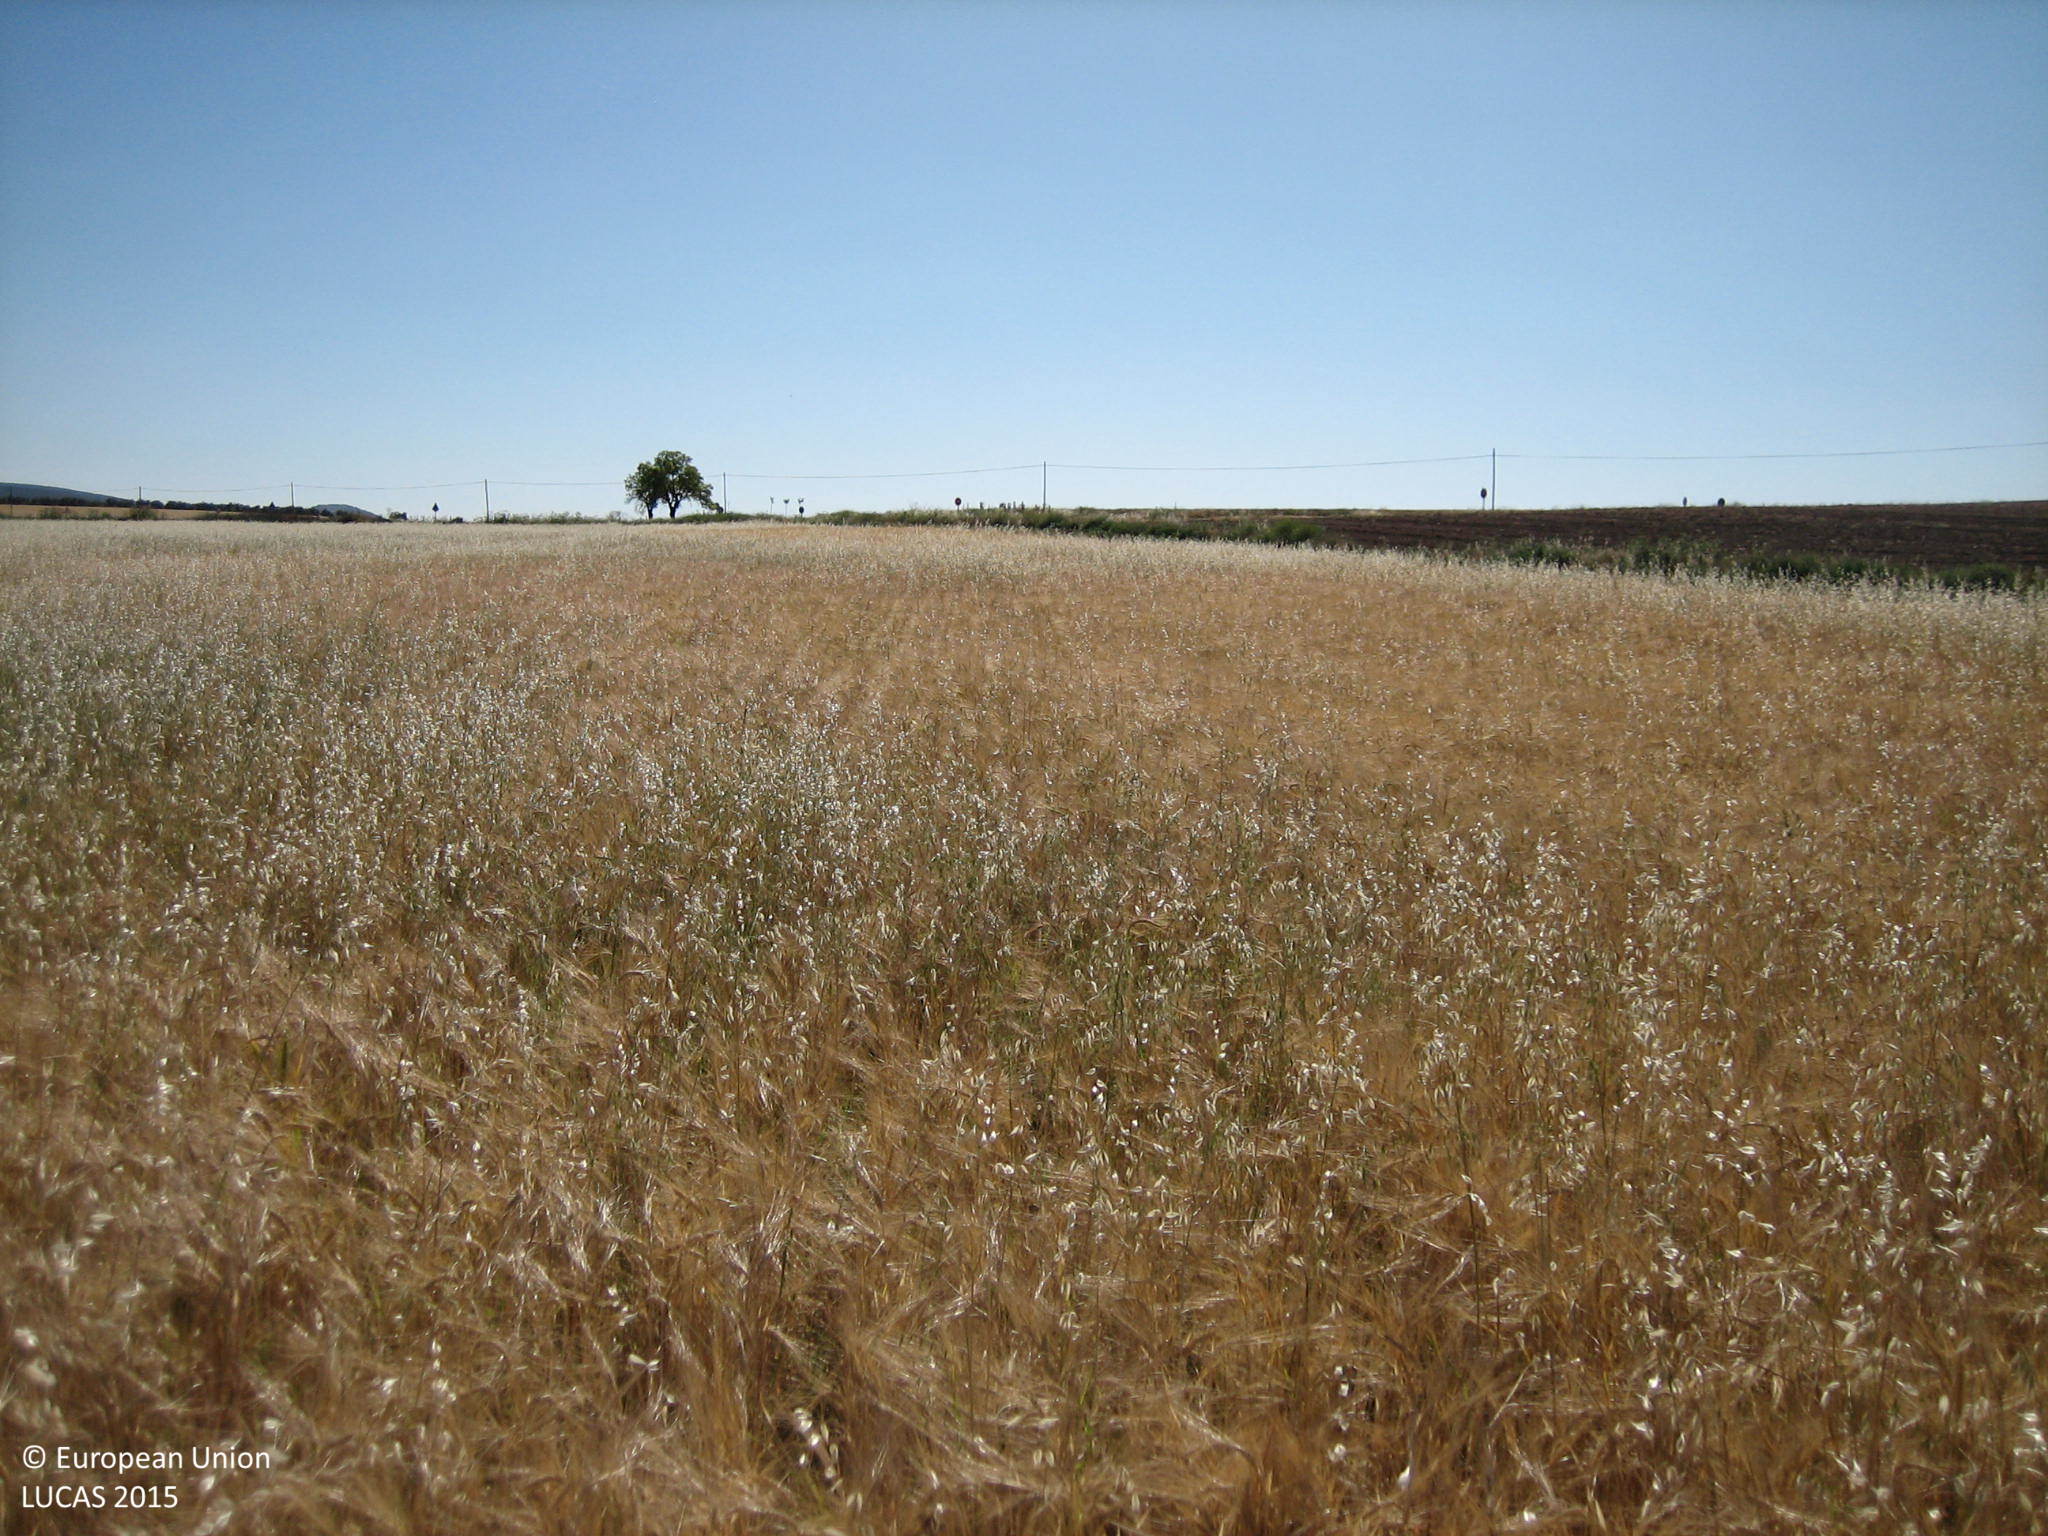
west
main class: Cropland
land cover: Barley
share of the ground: > 75 %
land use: Agriculture (excluding fallow land and kitchen gardens)
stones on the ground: < 10 %
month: June
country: ES
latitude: 38.8661
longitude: -4.0461
